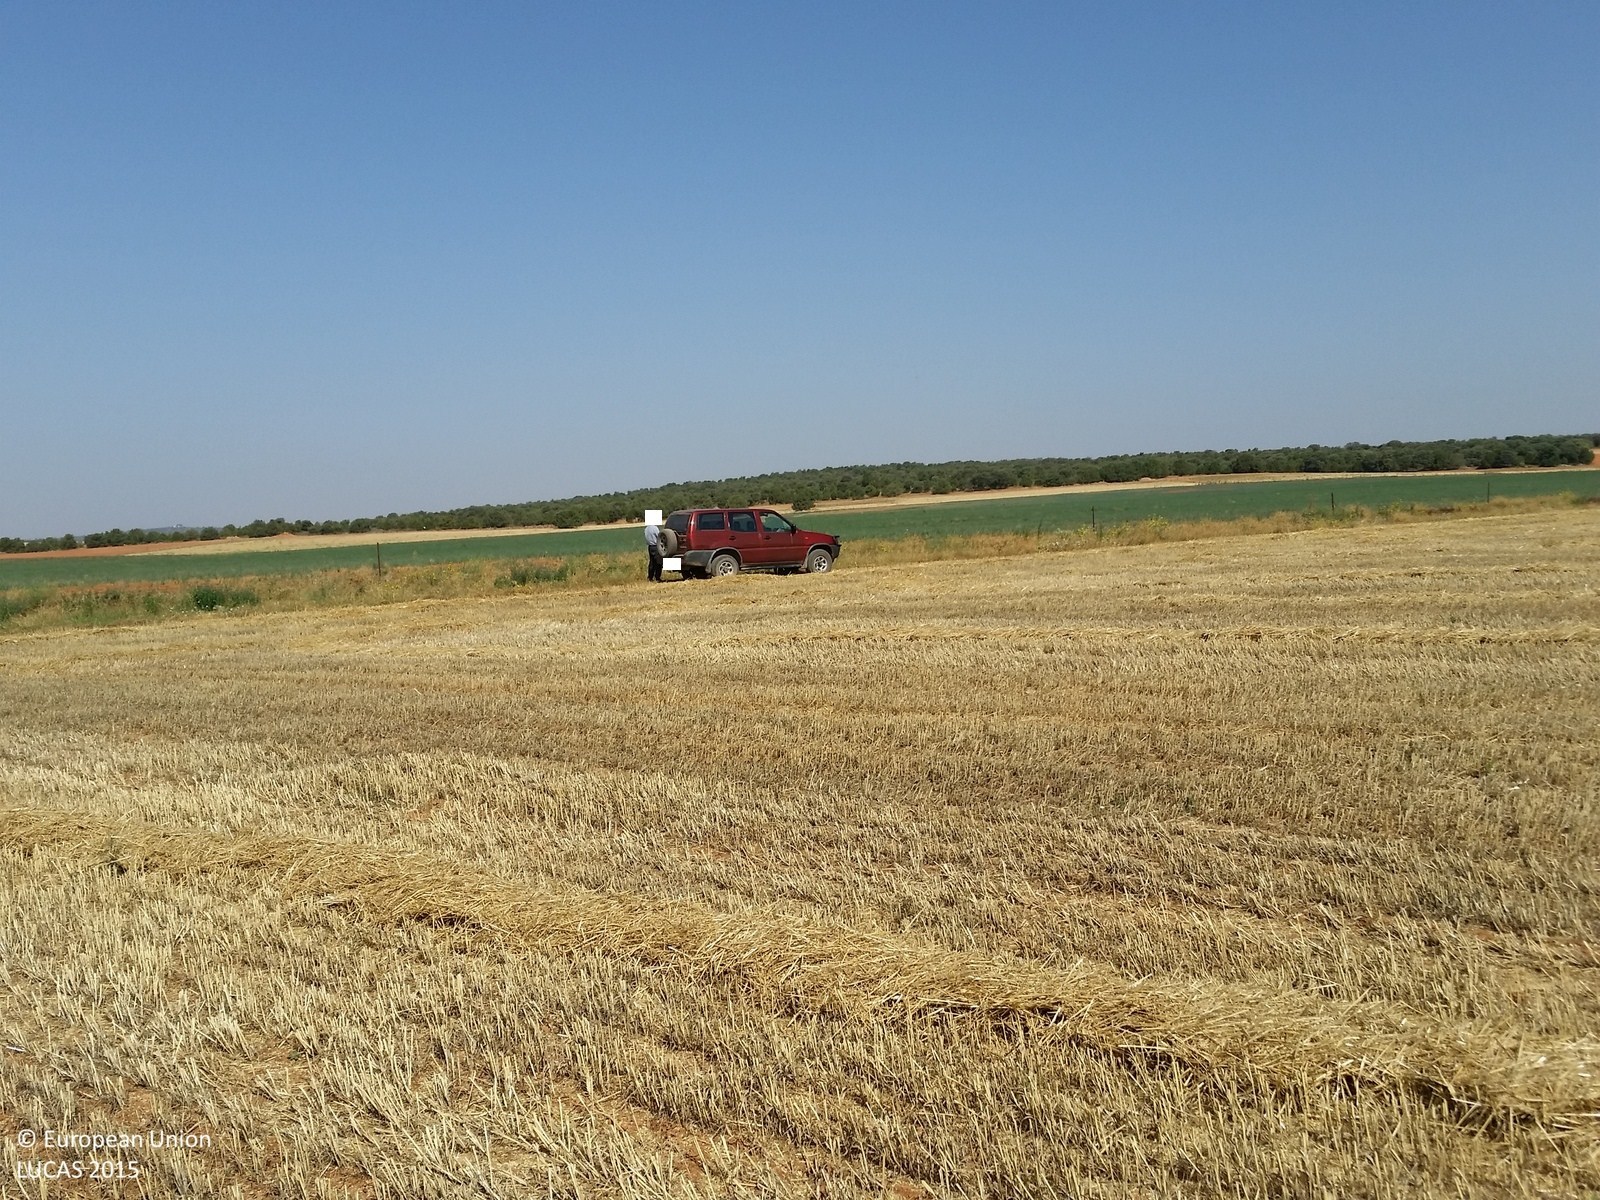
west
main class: Cropland
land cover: Common wheat
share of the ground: < 10 %
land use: Agriculture (excluding fallow land and kitchen gardens)
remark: Harvested field
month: July
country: ES
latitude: 38.9460
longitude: -2.6868
